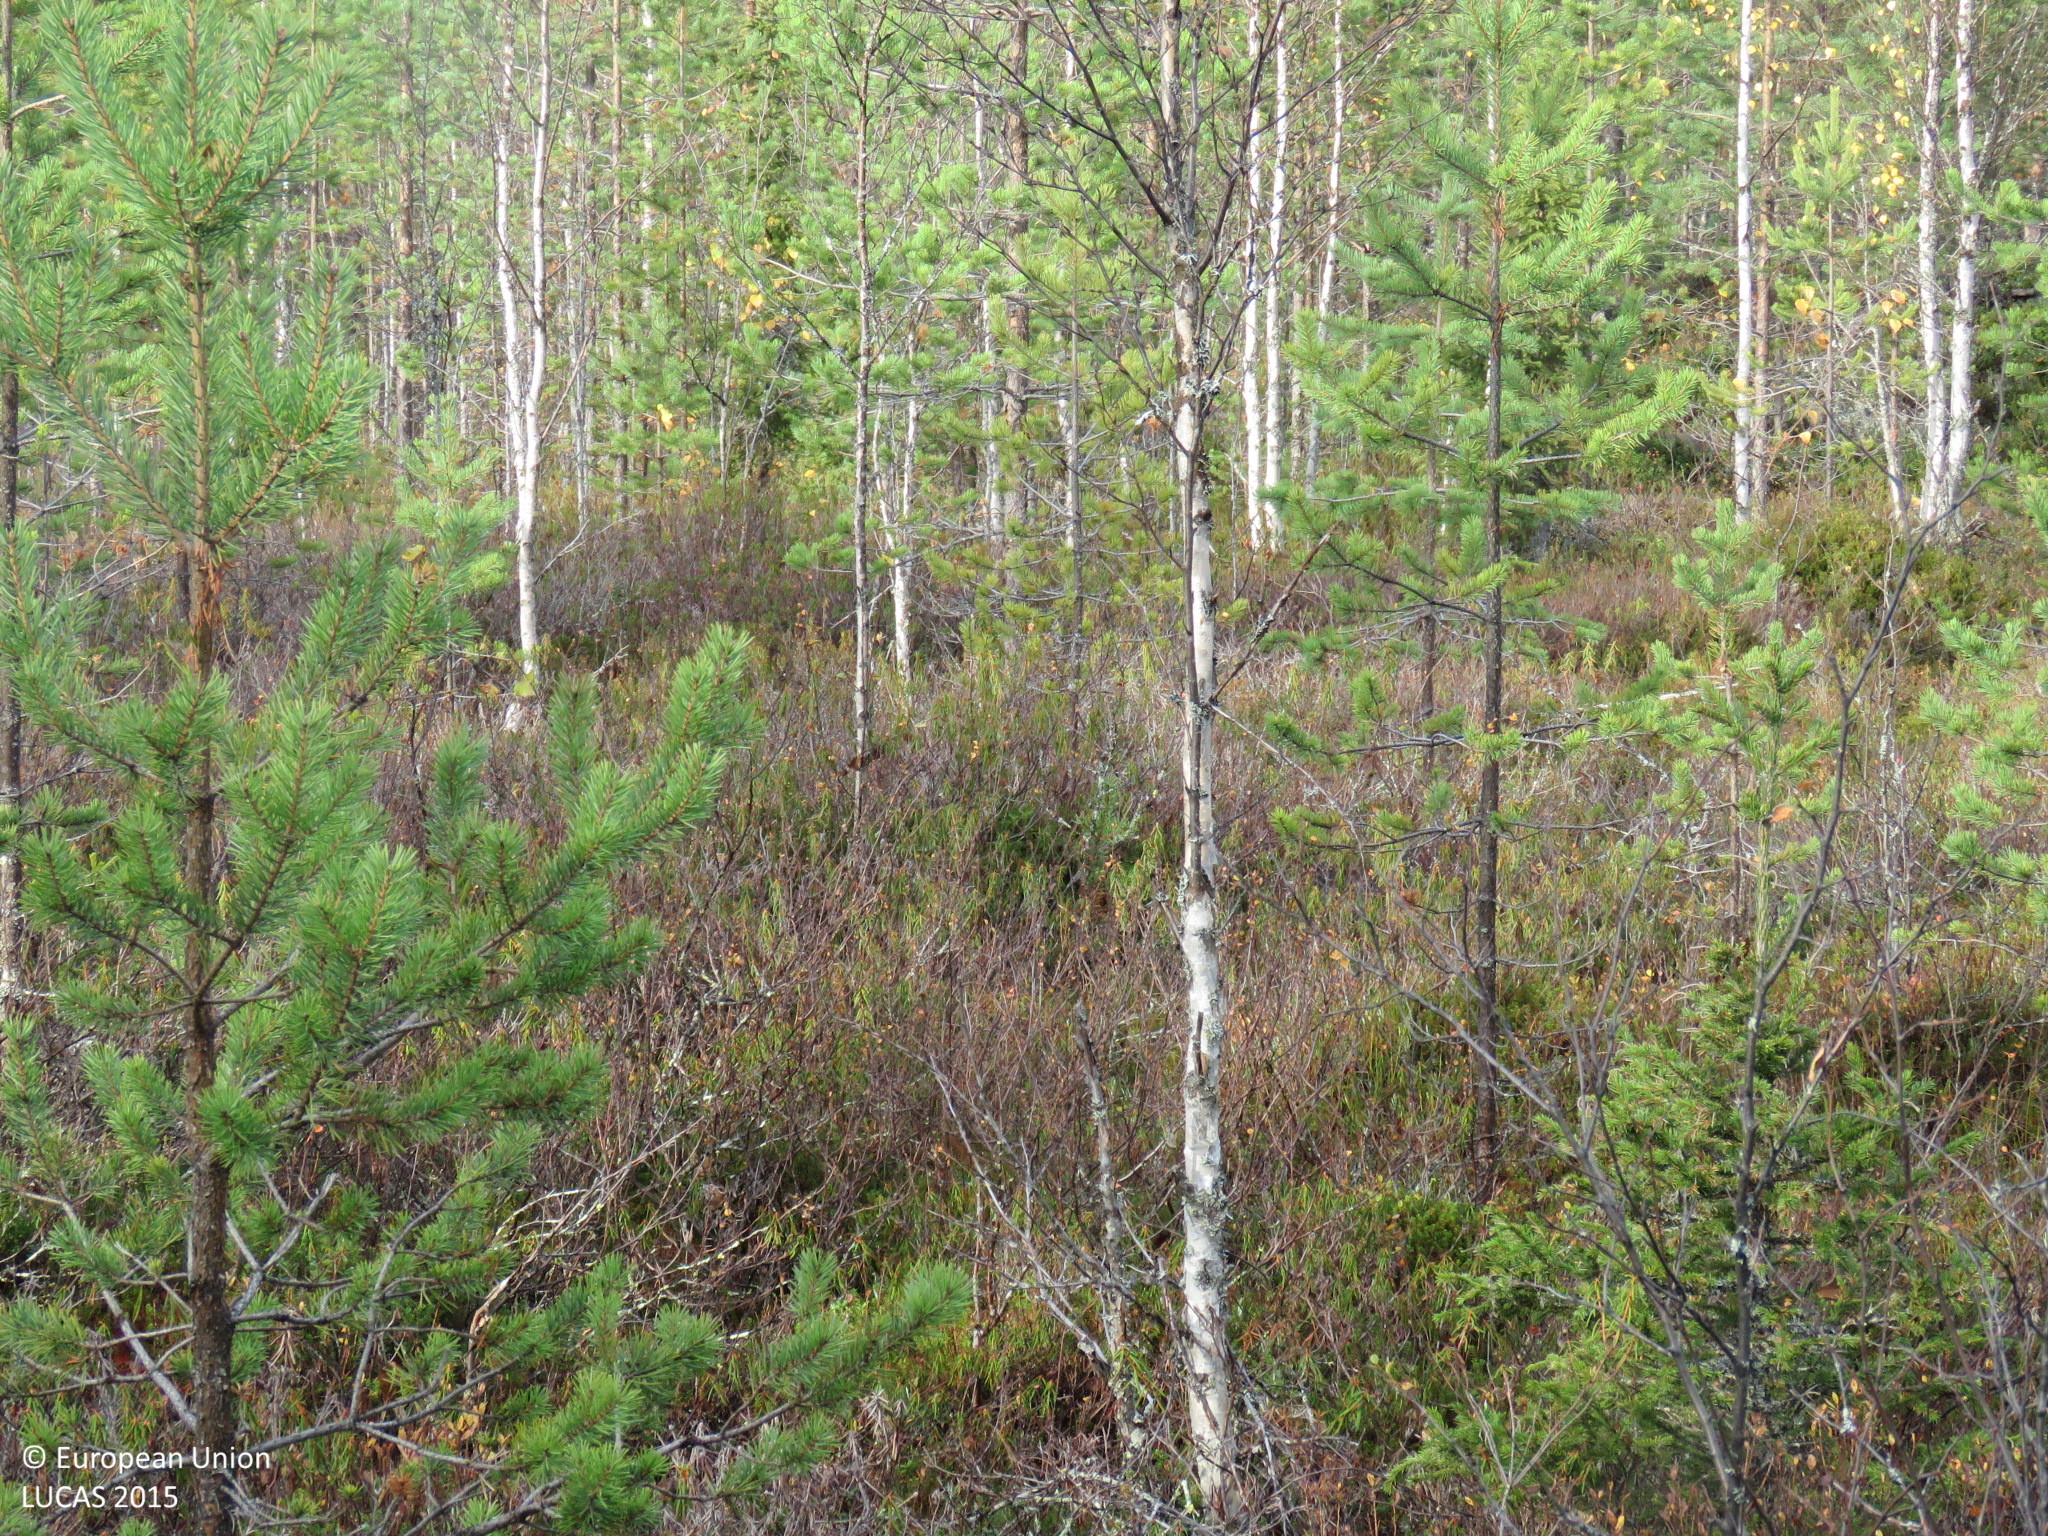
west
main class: Woodland
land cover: Other mixed woodland
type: boreal forest
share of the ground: > 75 %
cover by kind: coniferous forest trees 55 %, broadleaved forest trees 30 %, shrubs 10 %, lichens and mosses 5 %
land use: Forestry
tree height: > 5 m
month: September
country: FI
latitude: 64.9614
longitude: 27.1304
